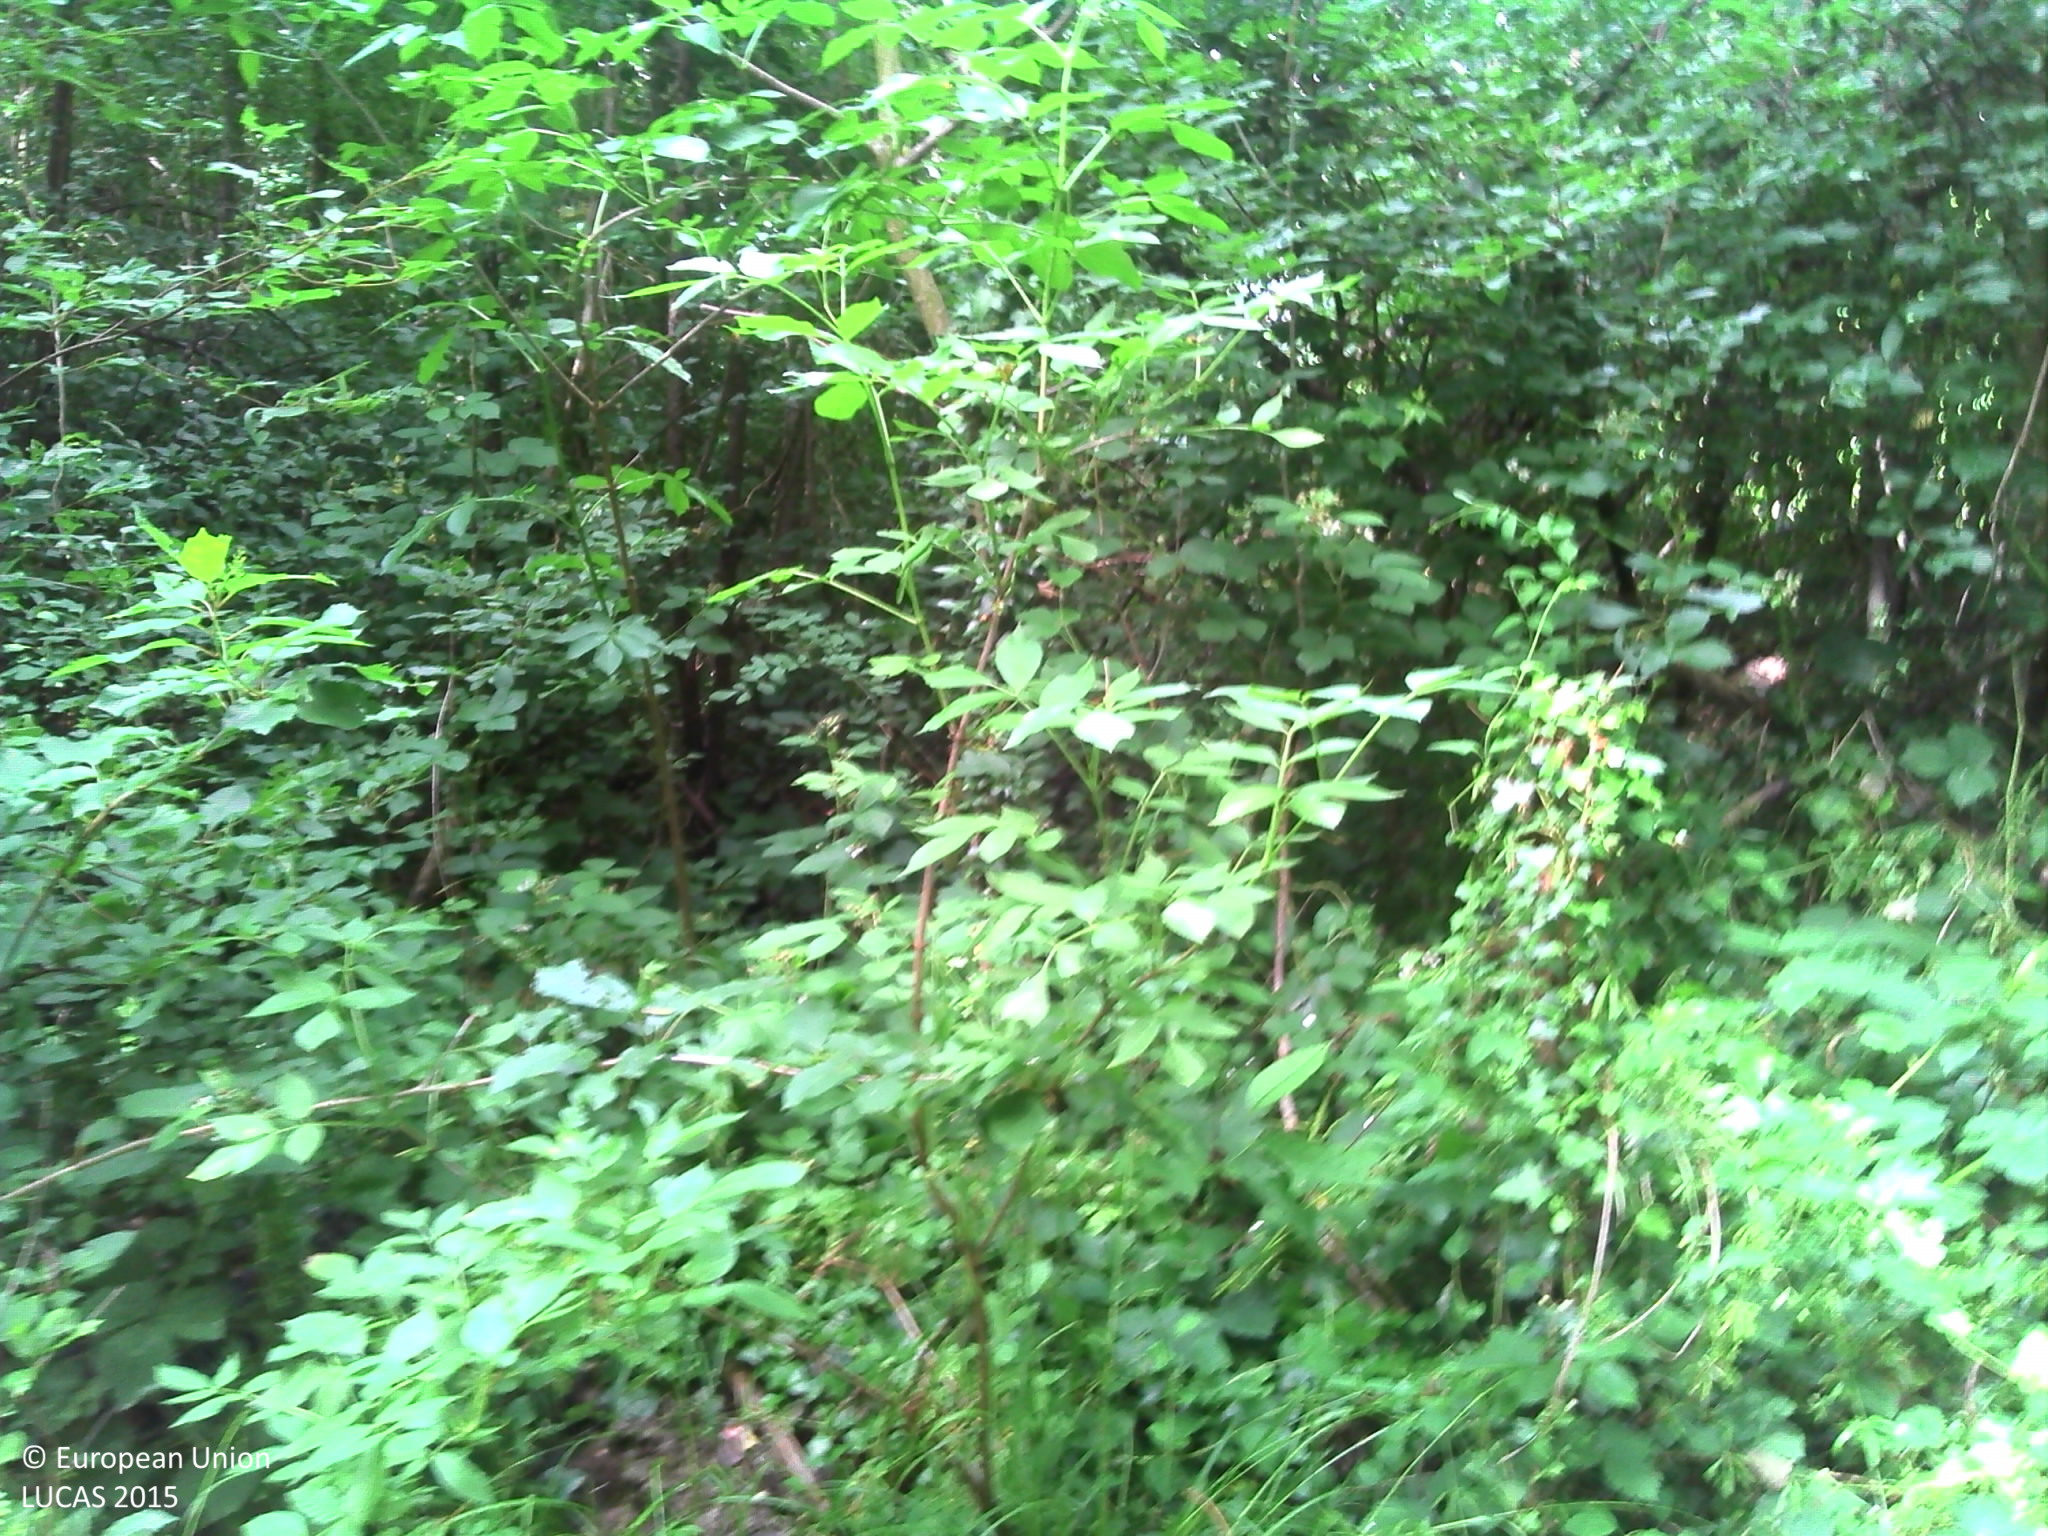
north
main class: Woodland
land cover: Broadleaved woodland
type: acidophilous oak and oak-birch forest
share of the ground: > 75 %
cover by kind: broadleaved forest trees 85 %, shrubs 10 %, herbaceous plants 5 %
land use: Forestry
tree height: > 5 m
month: June
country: FR
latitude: 49.3755
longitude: 3.6442
